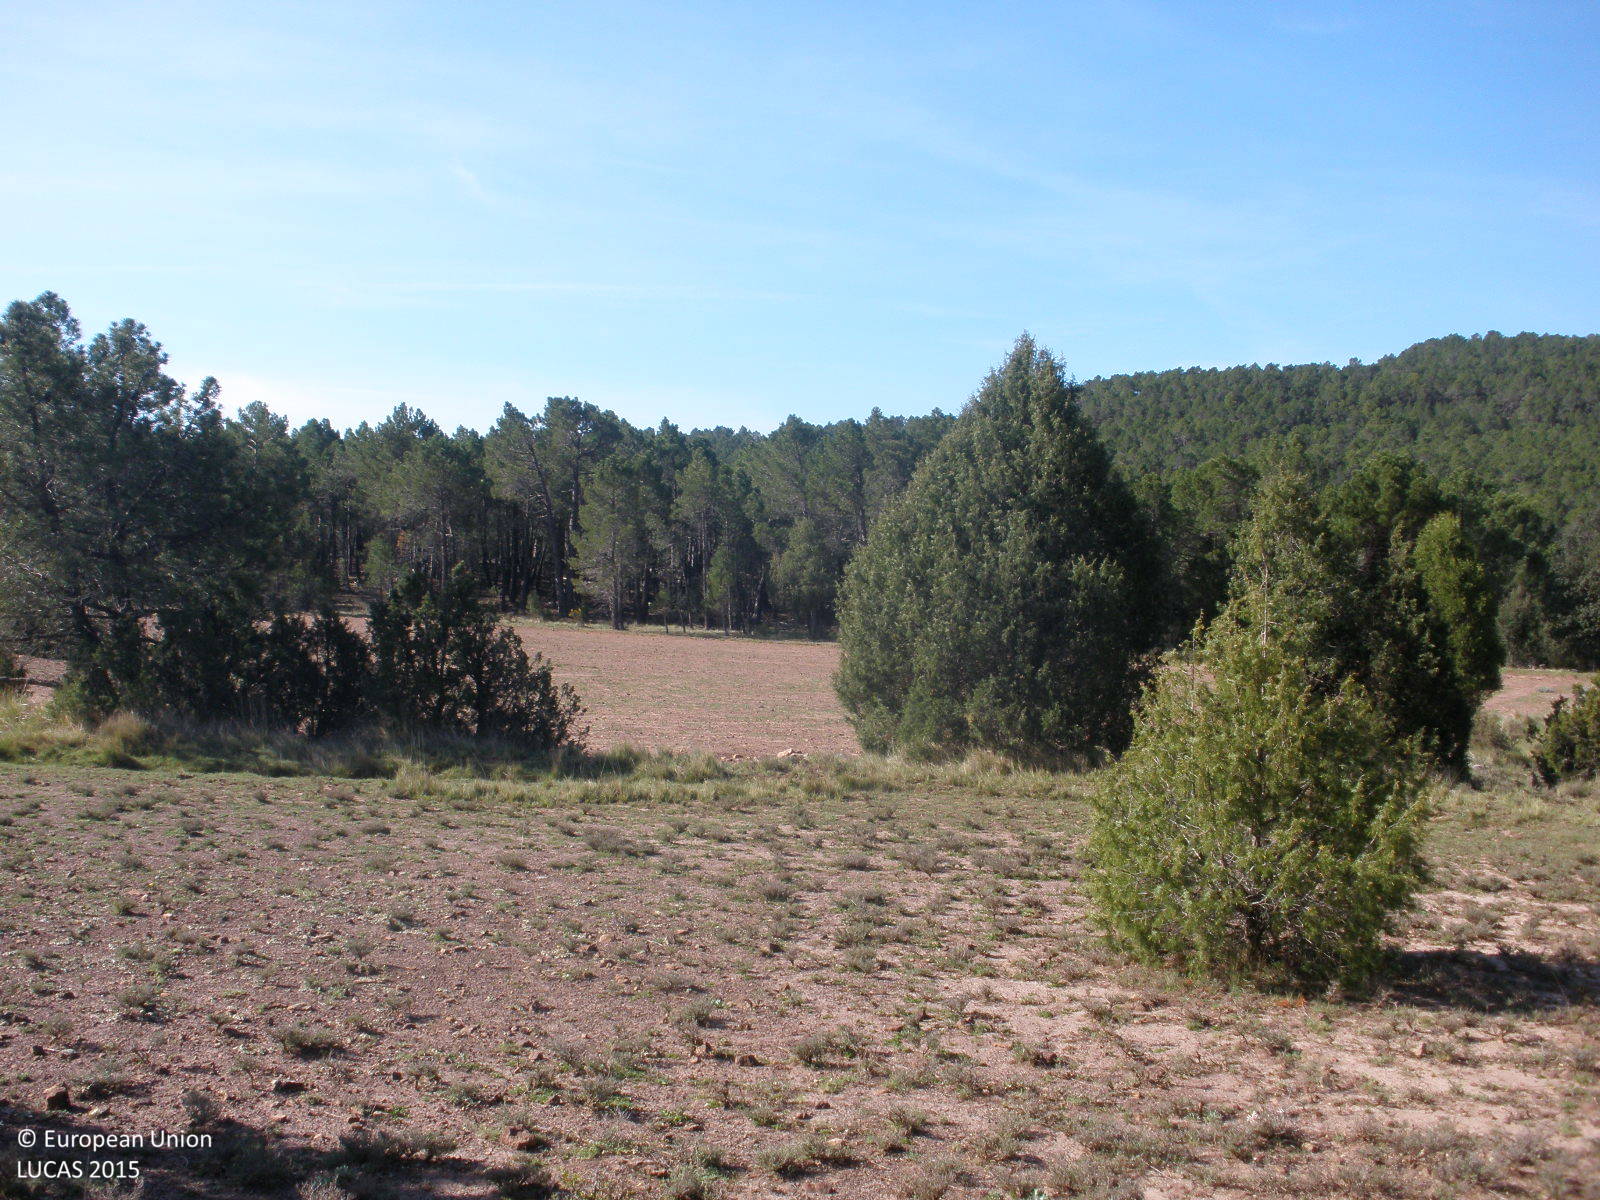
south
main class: Woodland
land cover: Other mixed woodland
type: coniferous forest of the mediterranean region
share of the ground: 50 - 75 %
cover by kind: consolidated bare surface 40 %, coniferous forest trees 30 %, broadleaved forest trees 20 %, shrubs 10 %
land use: Semi-natural and natural areas not in use
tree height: < 5 m
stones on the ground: 25 - 50 %
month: April
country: ES
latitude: 40.2951
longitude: -0.7484
